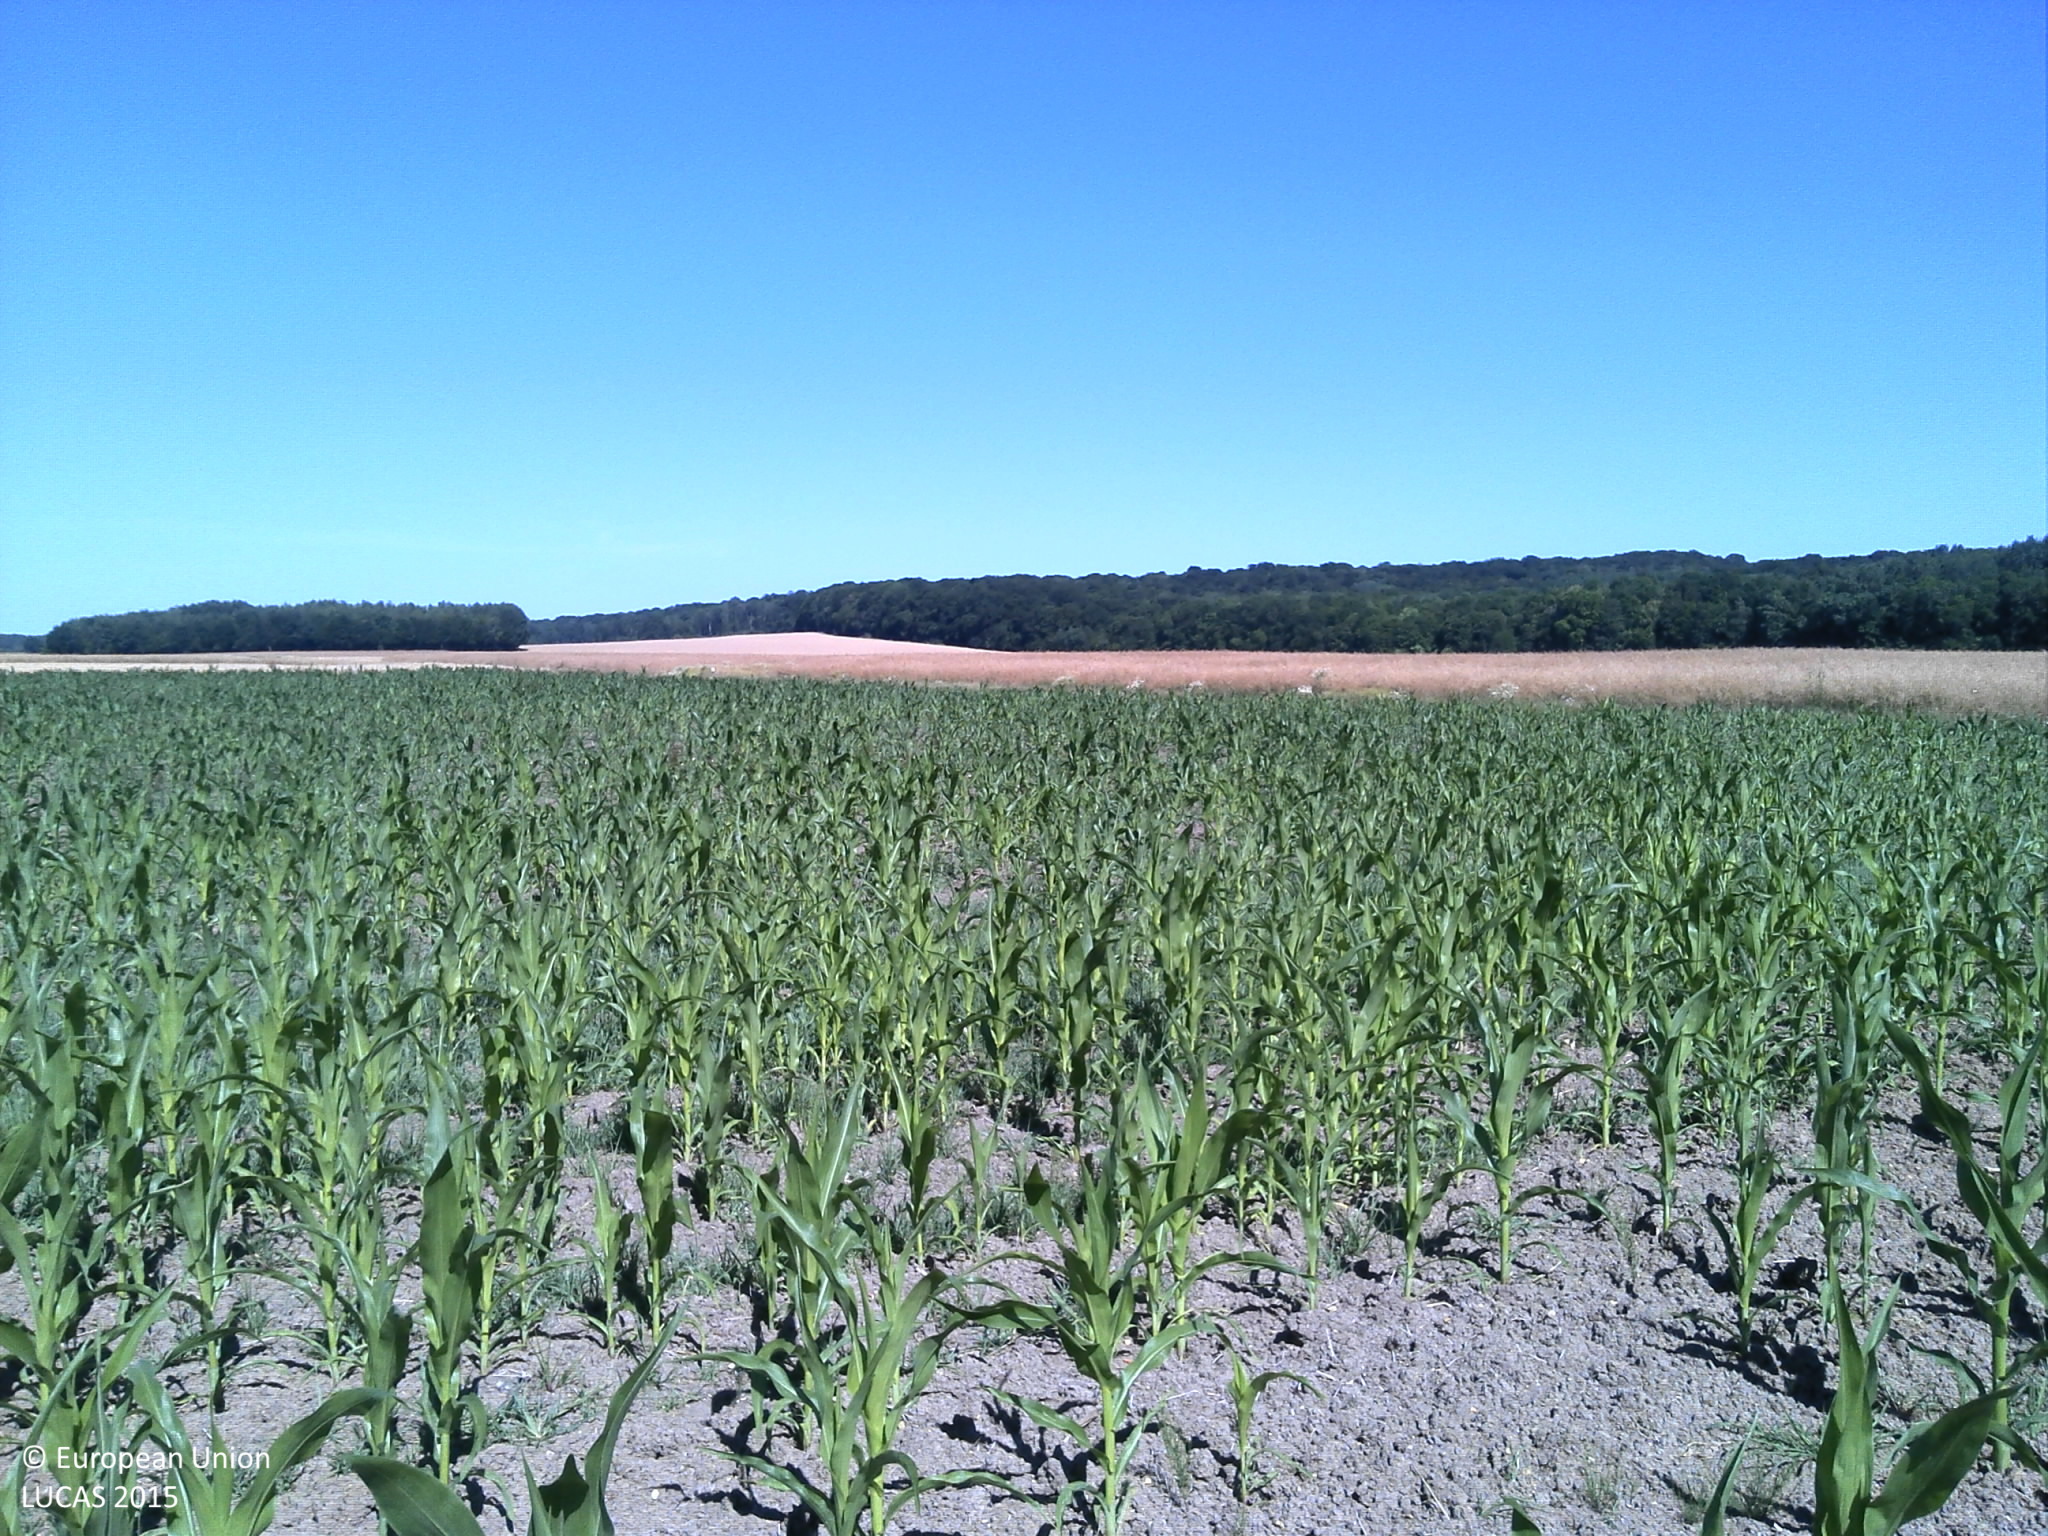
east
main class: Cropland
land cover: Rape and turnip rape
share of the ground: > 75 %
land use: Agriculture (excluding fallow land and kitchen gardens)
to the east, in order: Rape and turnip rape; Maize; Tracks; Rape and turnip rape
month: July
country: FR
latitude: 49.4835
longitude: 4.6825
